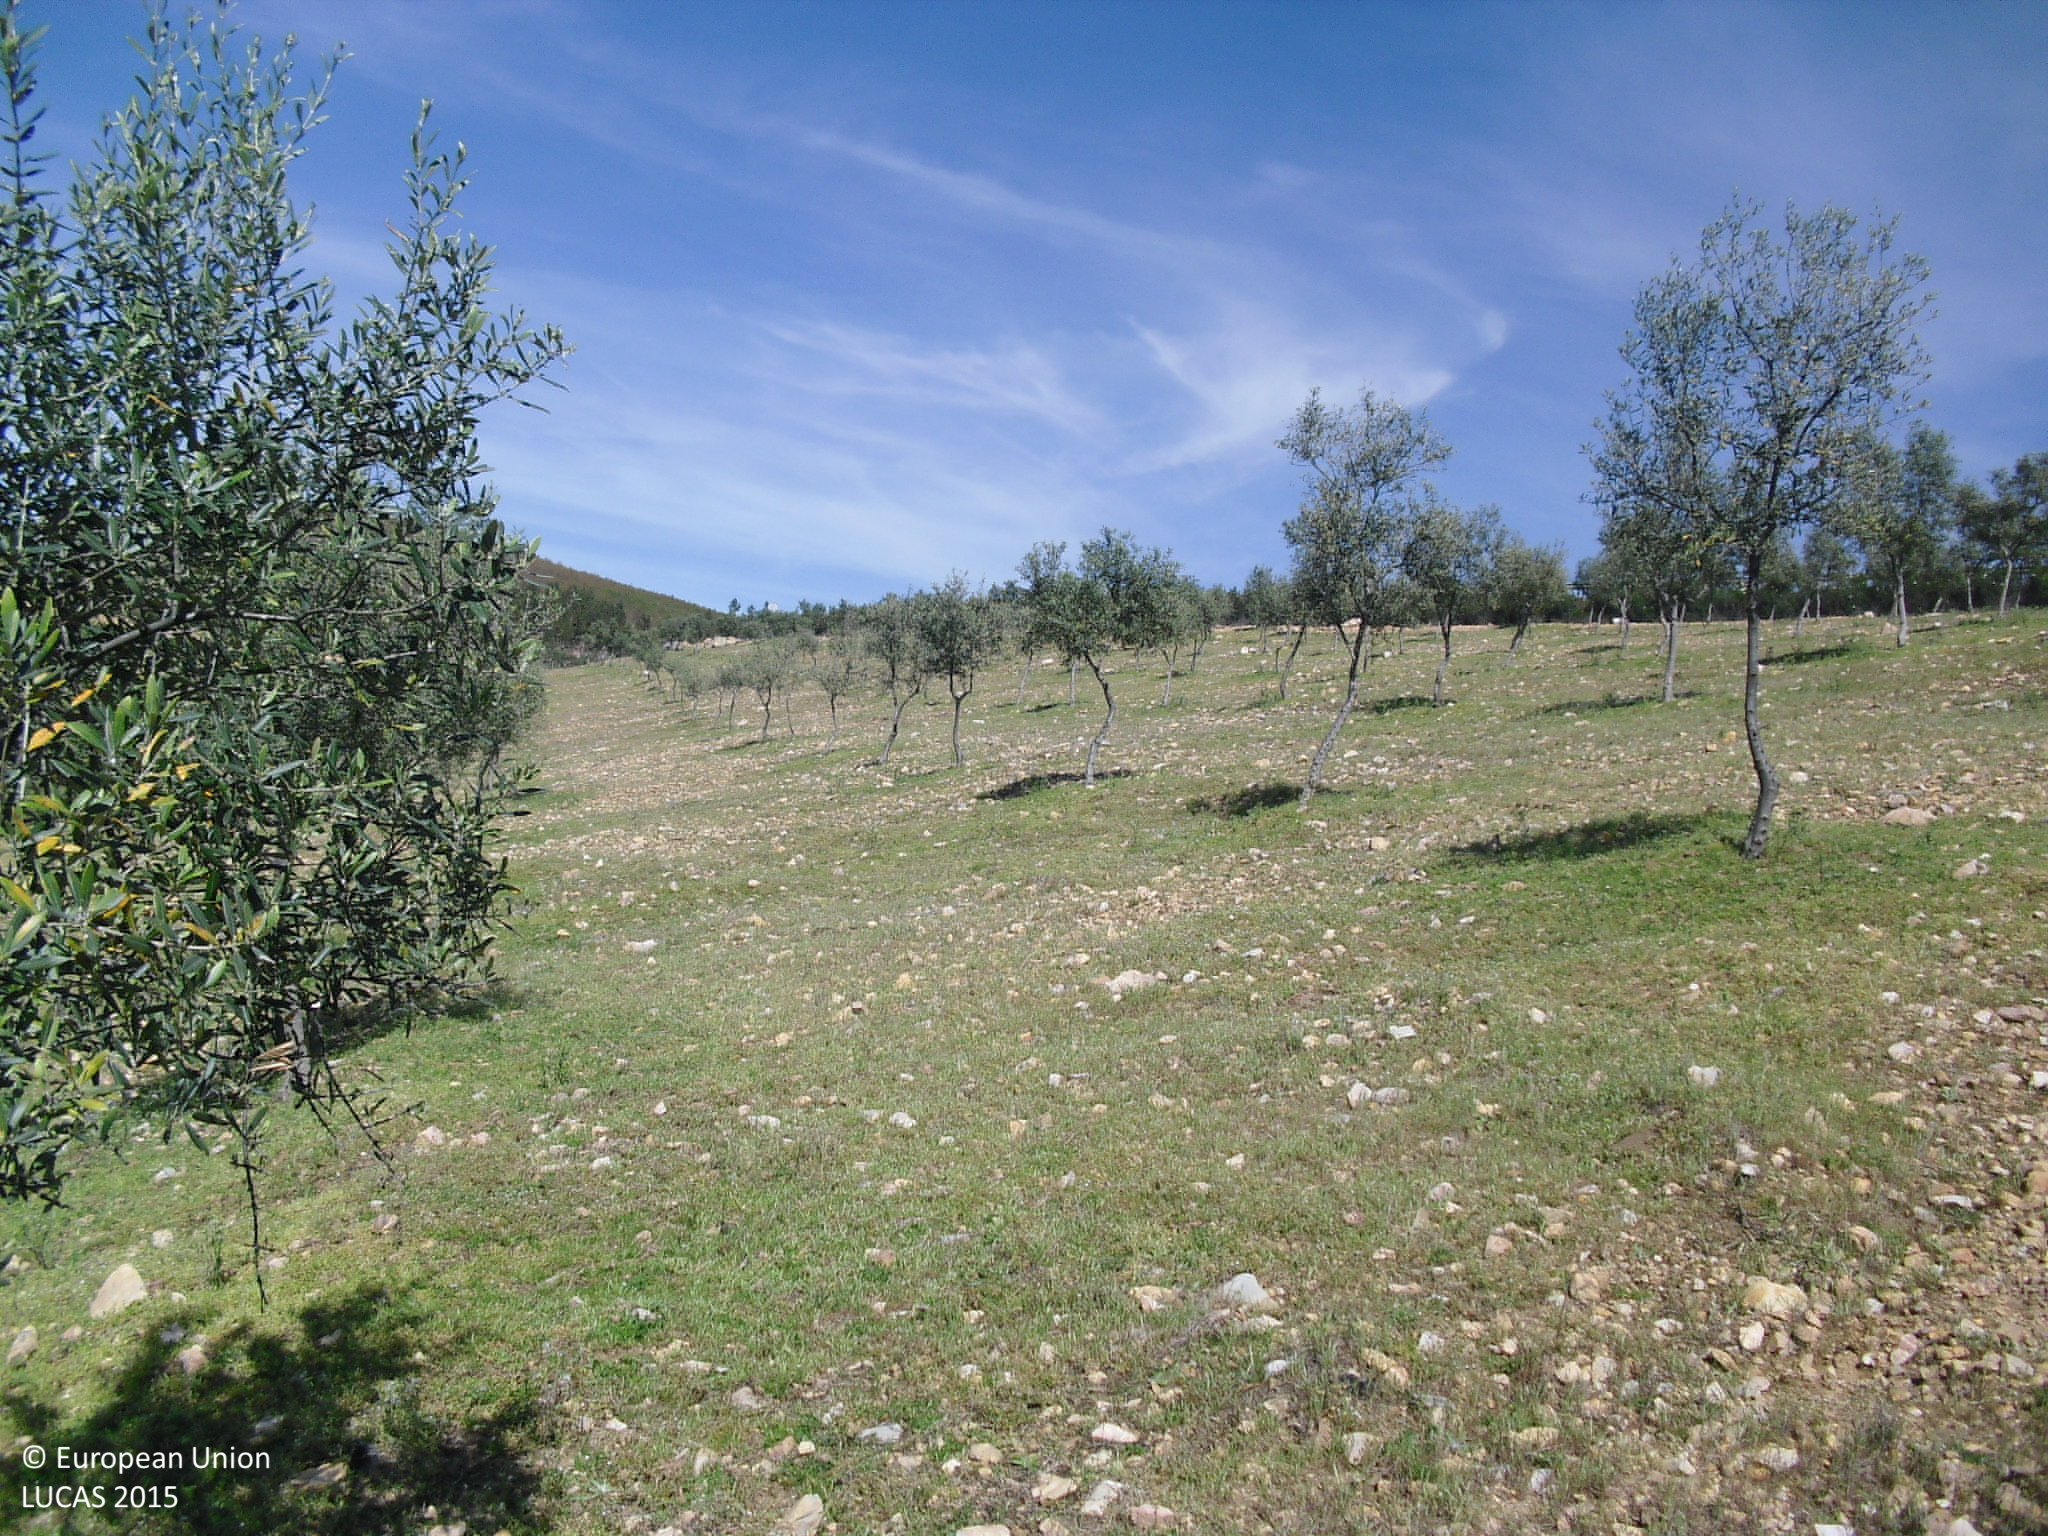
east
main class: Cropland
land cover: Olive groves
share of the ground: 10 - 25 %
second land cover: Spontaneously vegetated surfaces
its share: > 75 %
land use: Agriculture (excluding fallow land and kitchen gardens)
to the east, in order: Olive groves; Spontaneously vegetated surfaces; Other structural elements; Fences; Shruby margins; Paved roads, cycling and walking lanes; Shruby margins; Fences; Shrubland without tree cover; Shrubland with sparse tree cover; Shrubland without tree cover; Tracks; Grassland with sparse tree/shrub cover
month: April
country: ES
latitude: 39.3665
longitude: -5.3330
